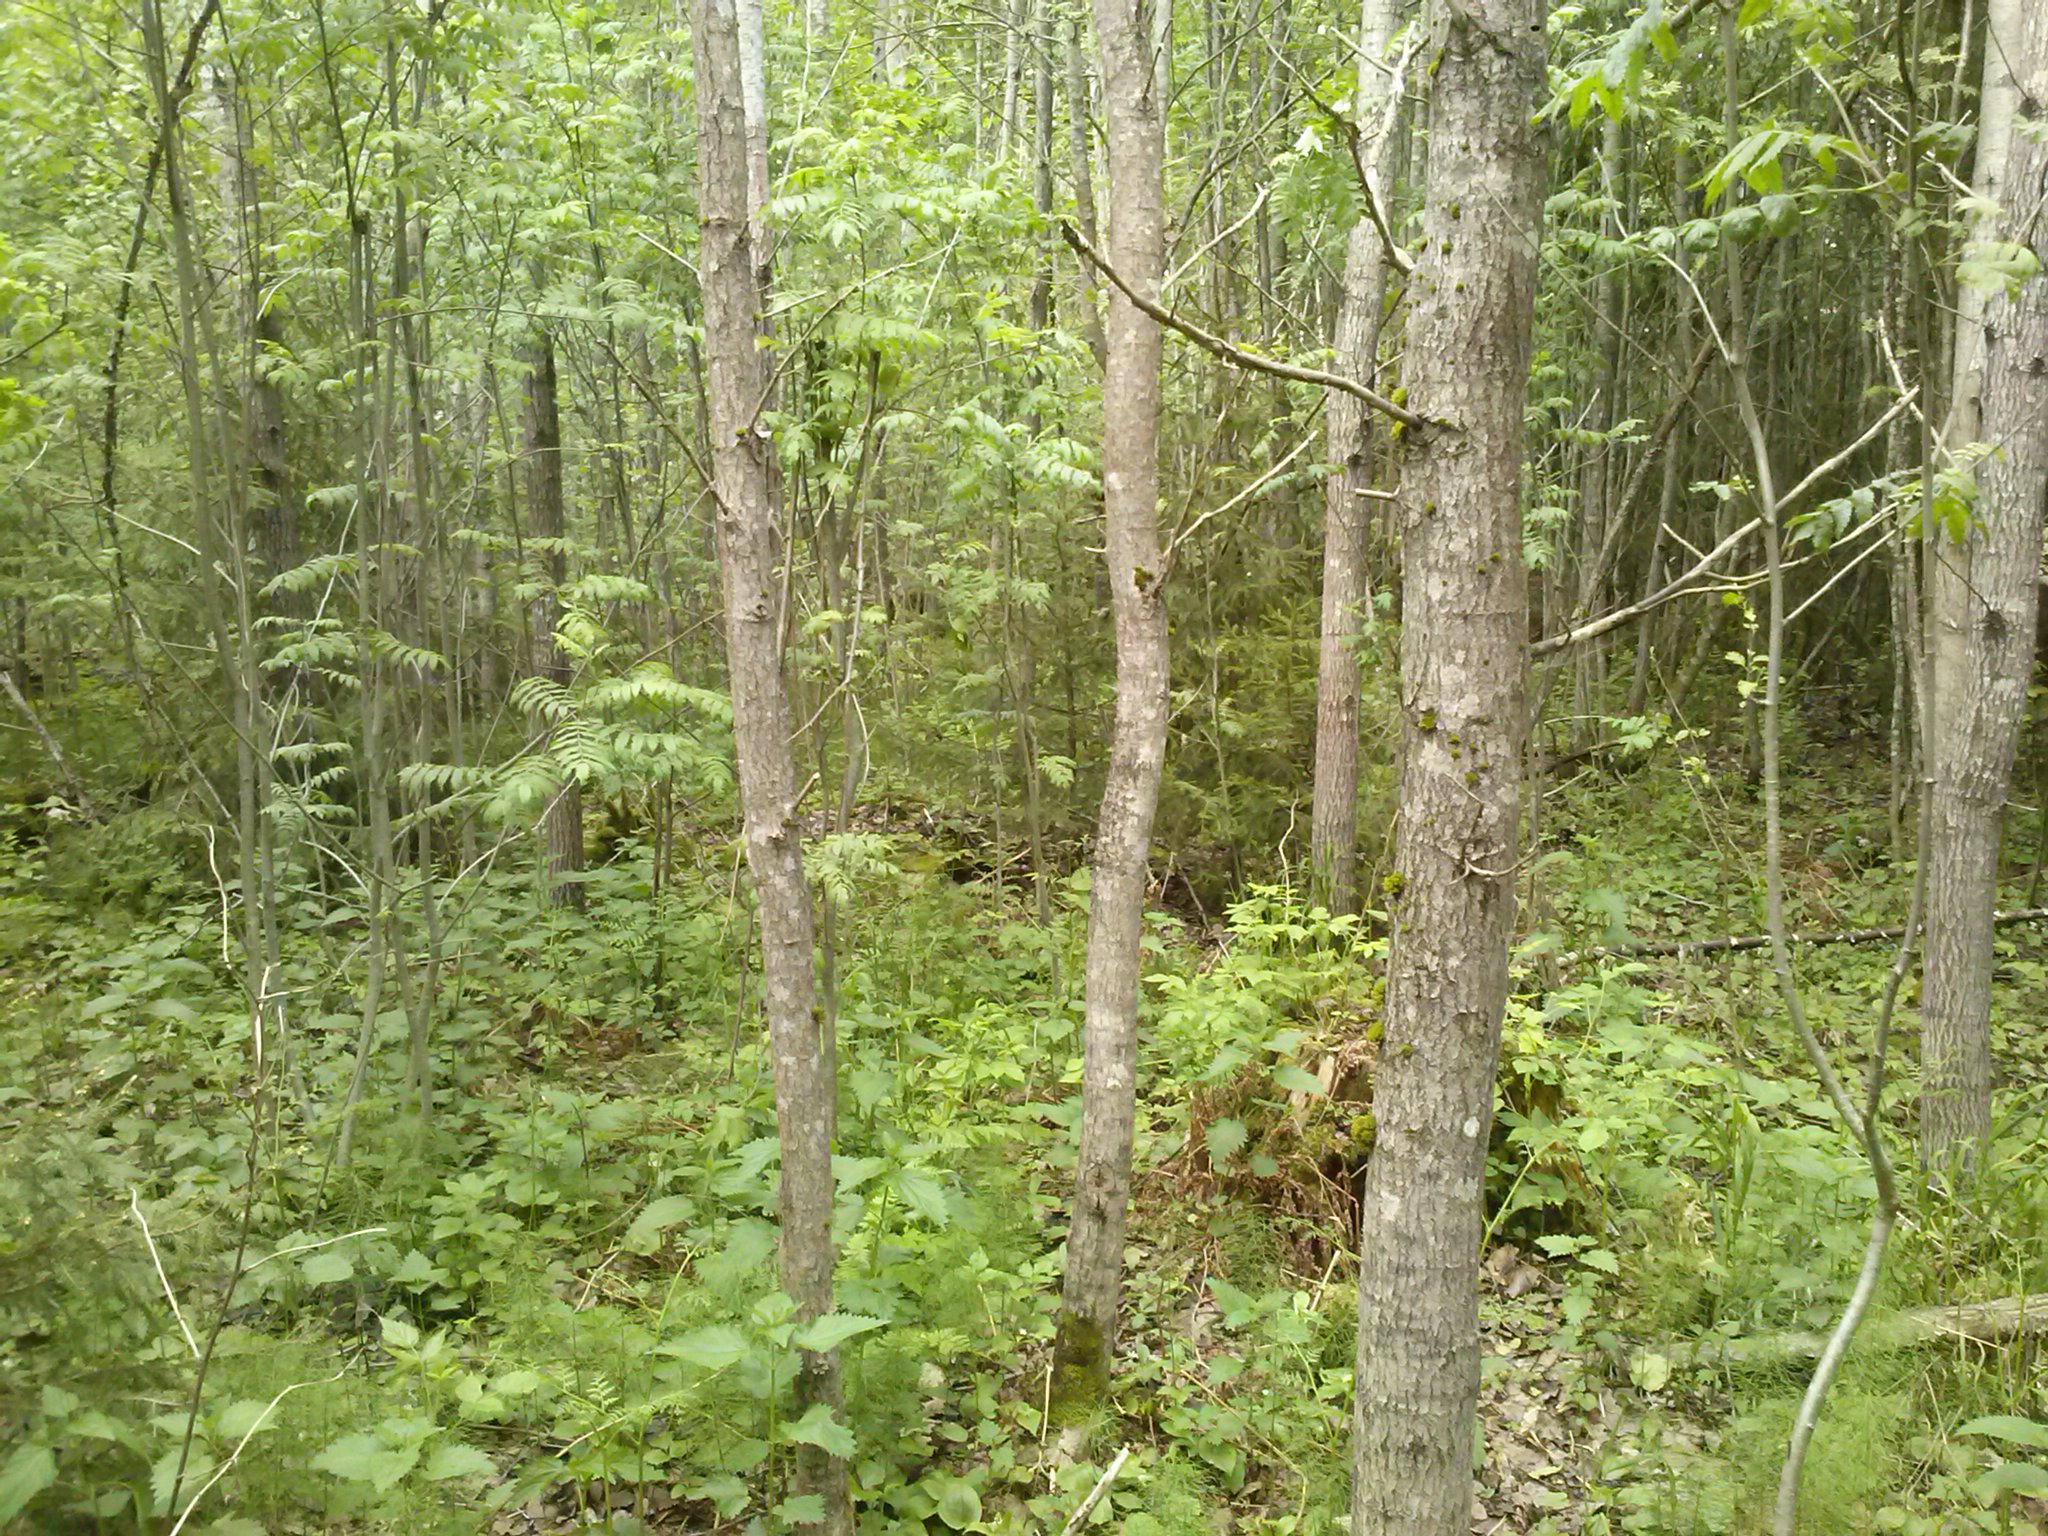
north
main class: Woodland
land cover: Broadleaved woodland
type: non-riverine alder, birch or aspen forest
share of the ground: > 75 %
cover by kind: broadleaved forest trees 80 %, coniferous forest trees 10 %, herbaceous plants 10 %
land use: Forestry
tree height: > 5 m
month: May
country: LV
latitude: 56.2270
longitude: 27.7542
